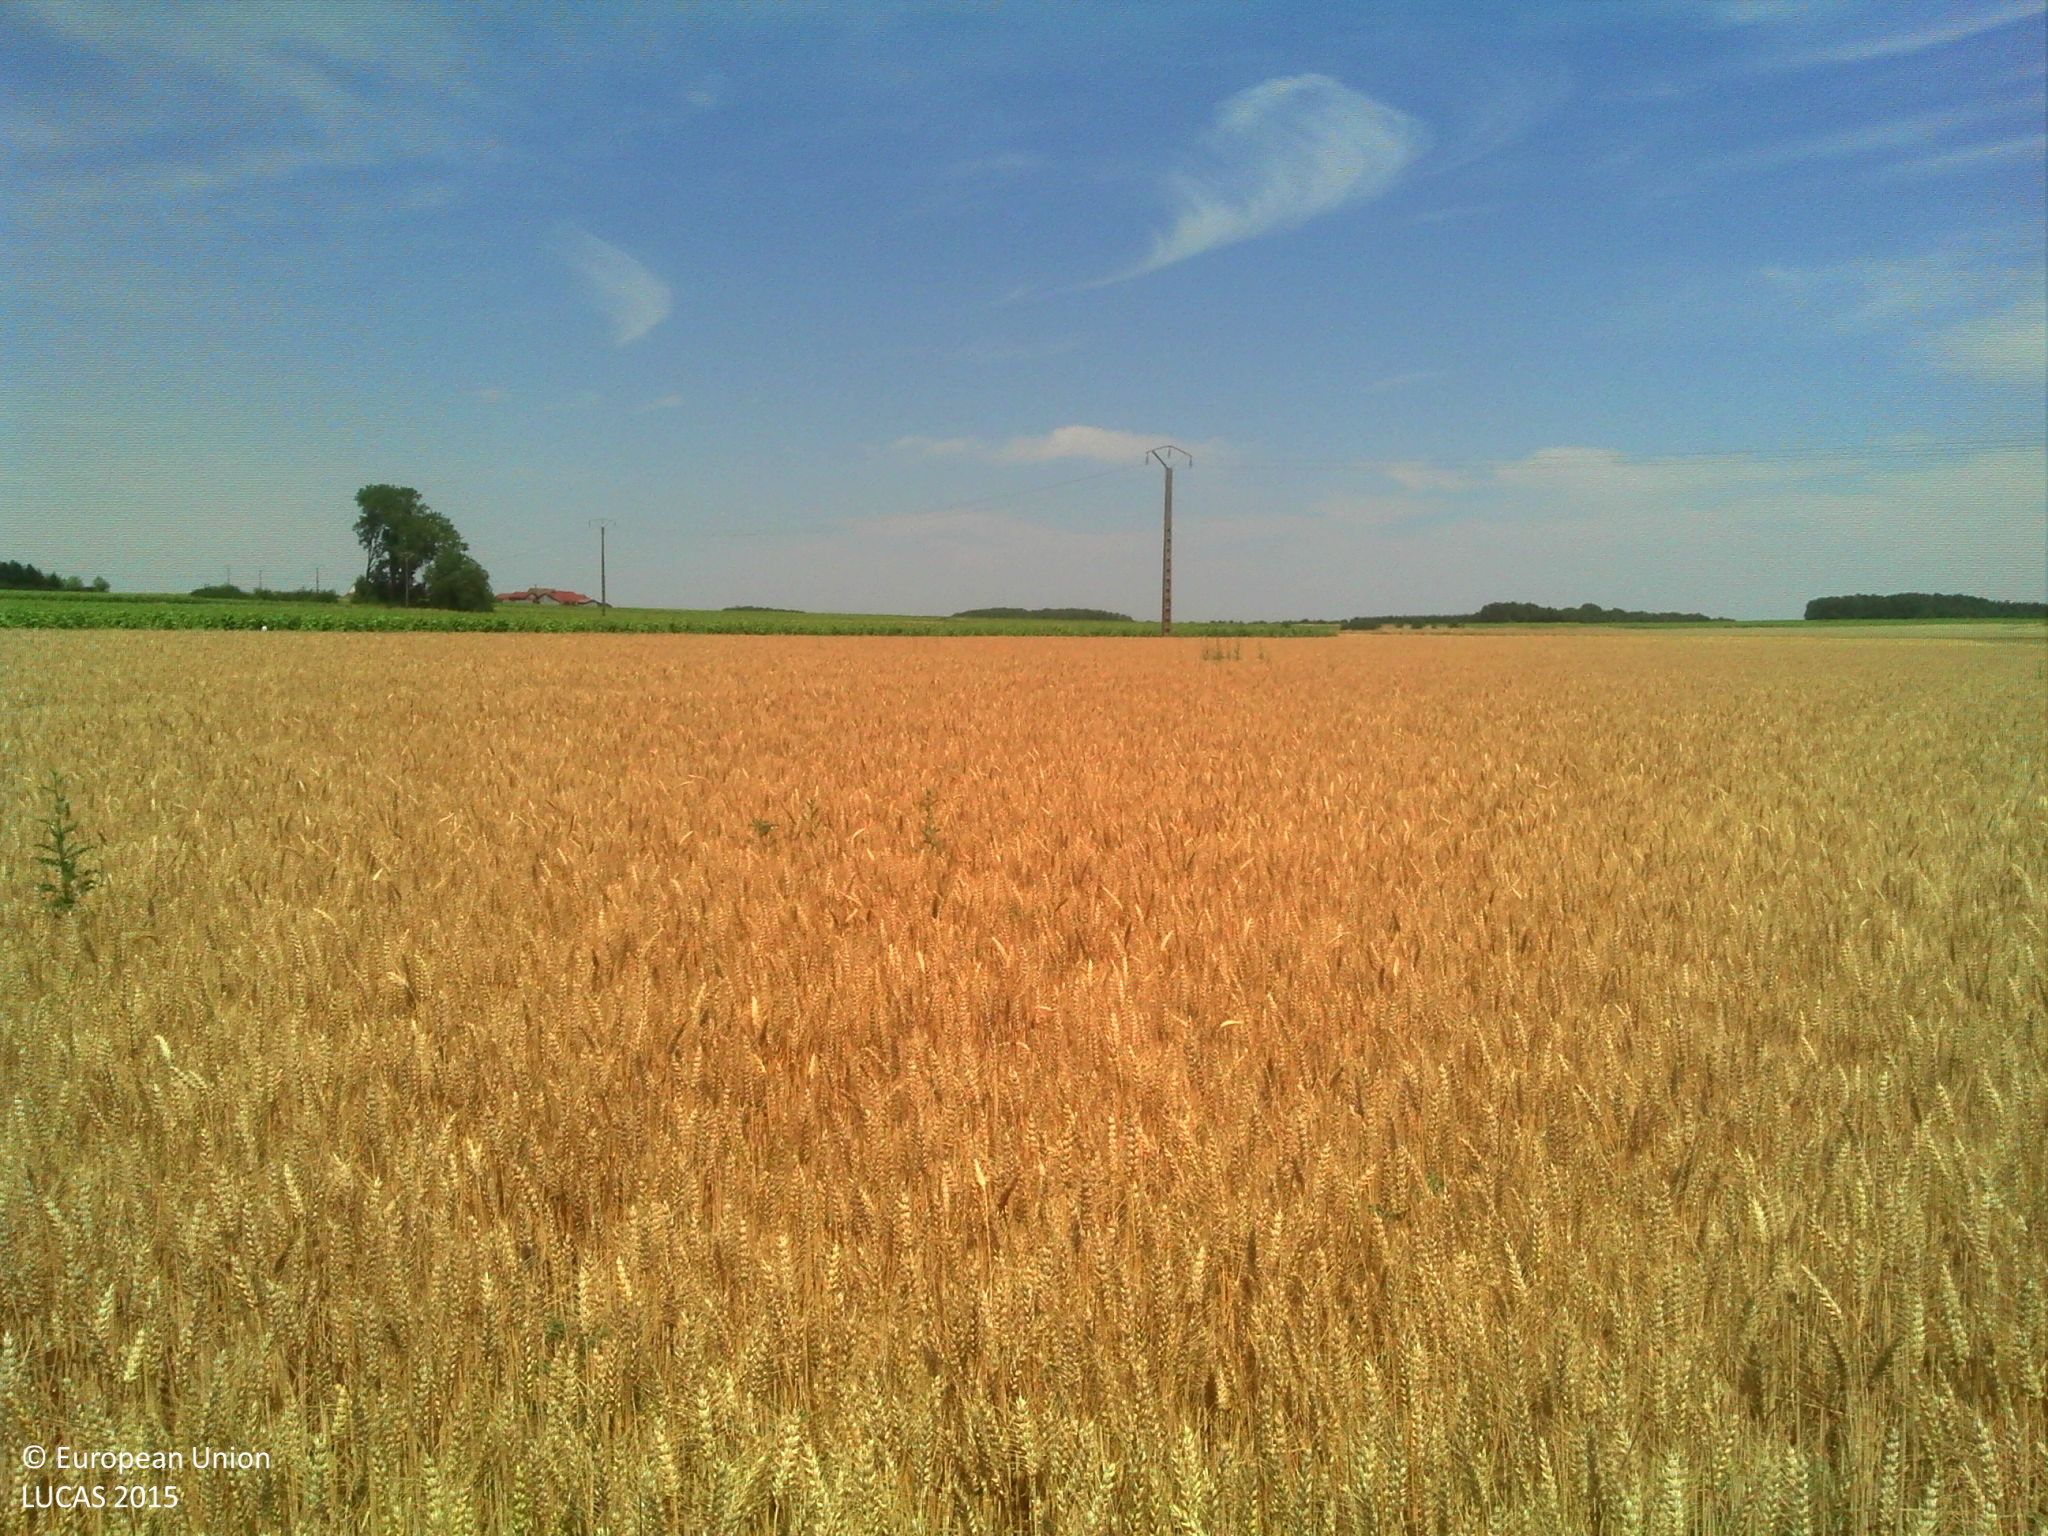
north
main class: Cropland
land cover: Durum wheat
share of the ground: > 75 %
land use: Agriculture (excluding fallow land and kitchen gardens)
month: June
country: FR
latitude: 47.3952
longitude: 1.3605
